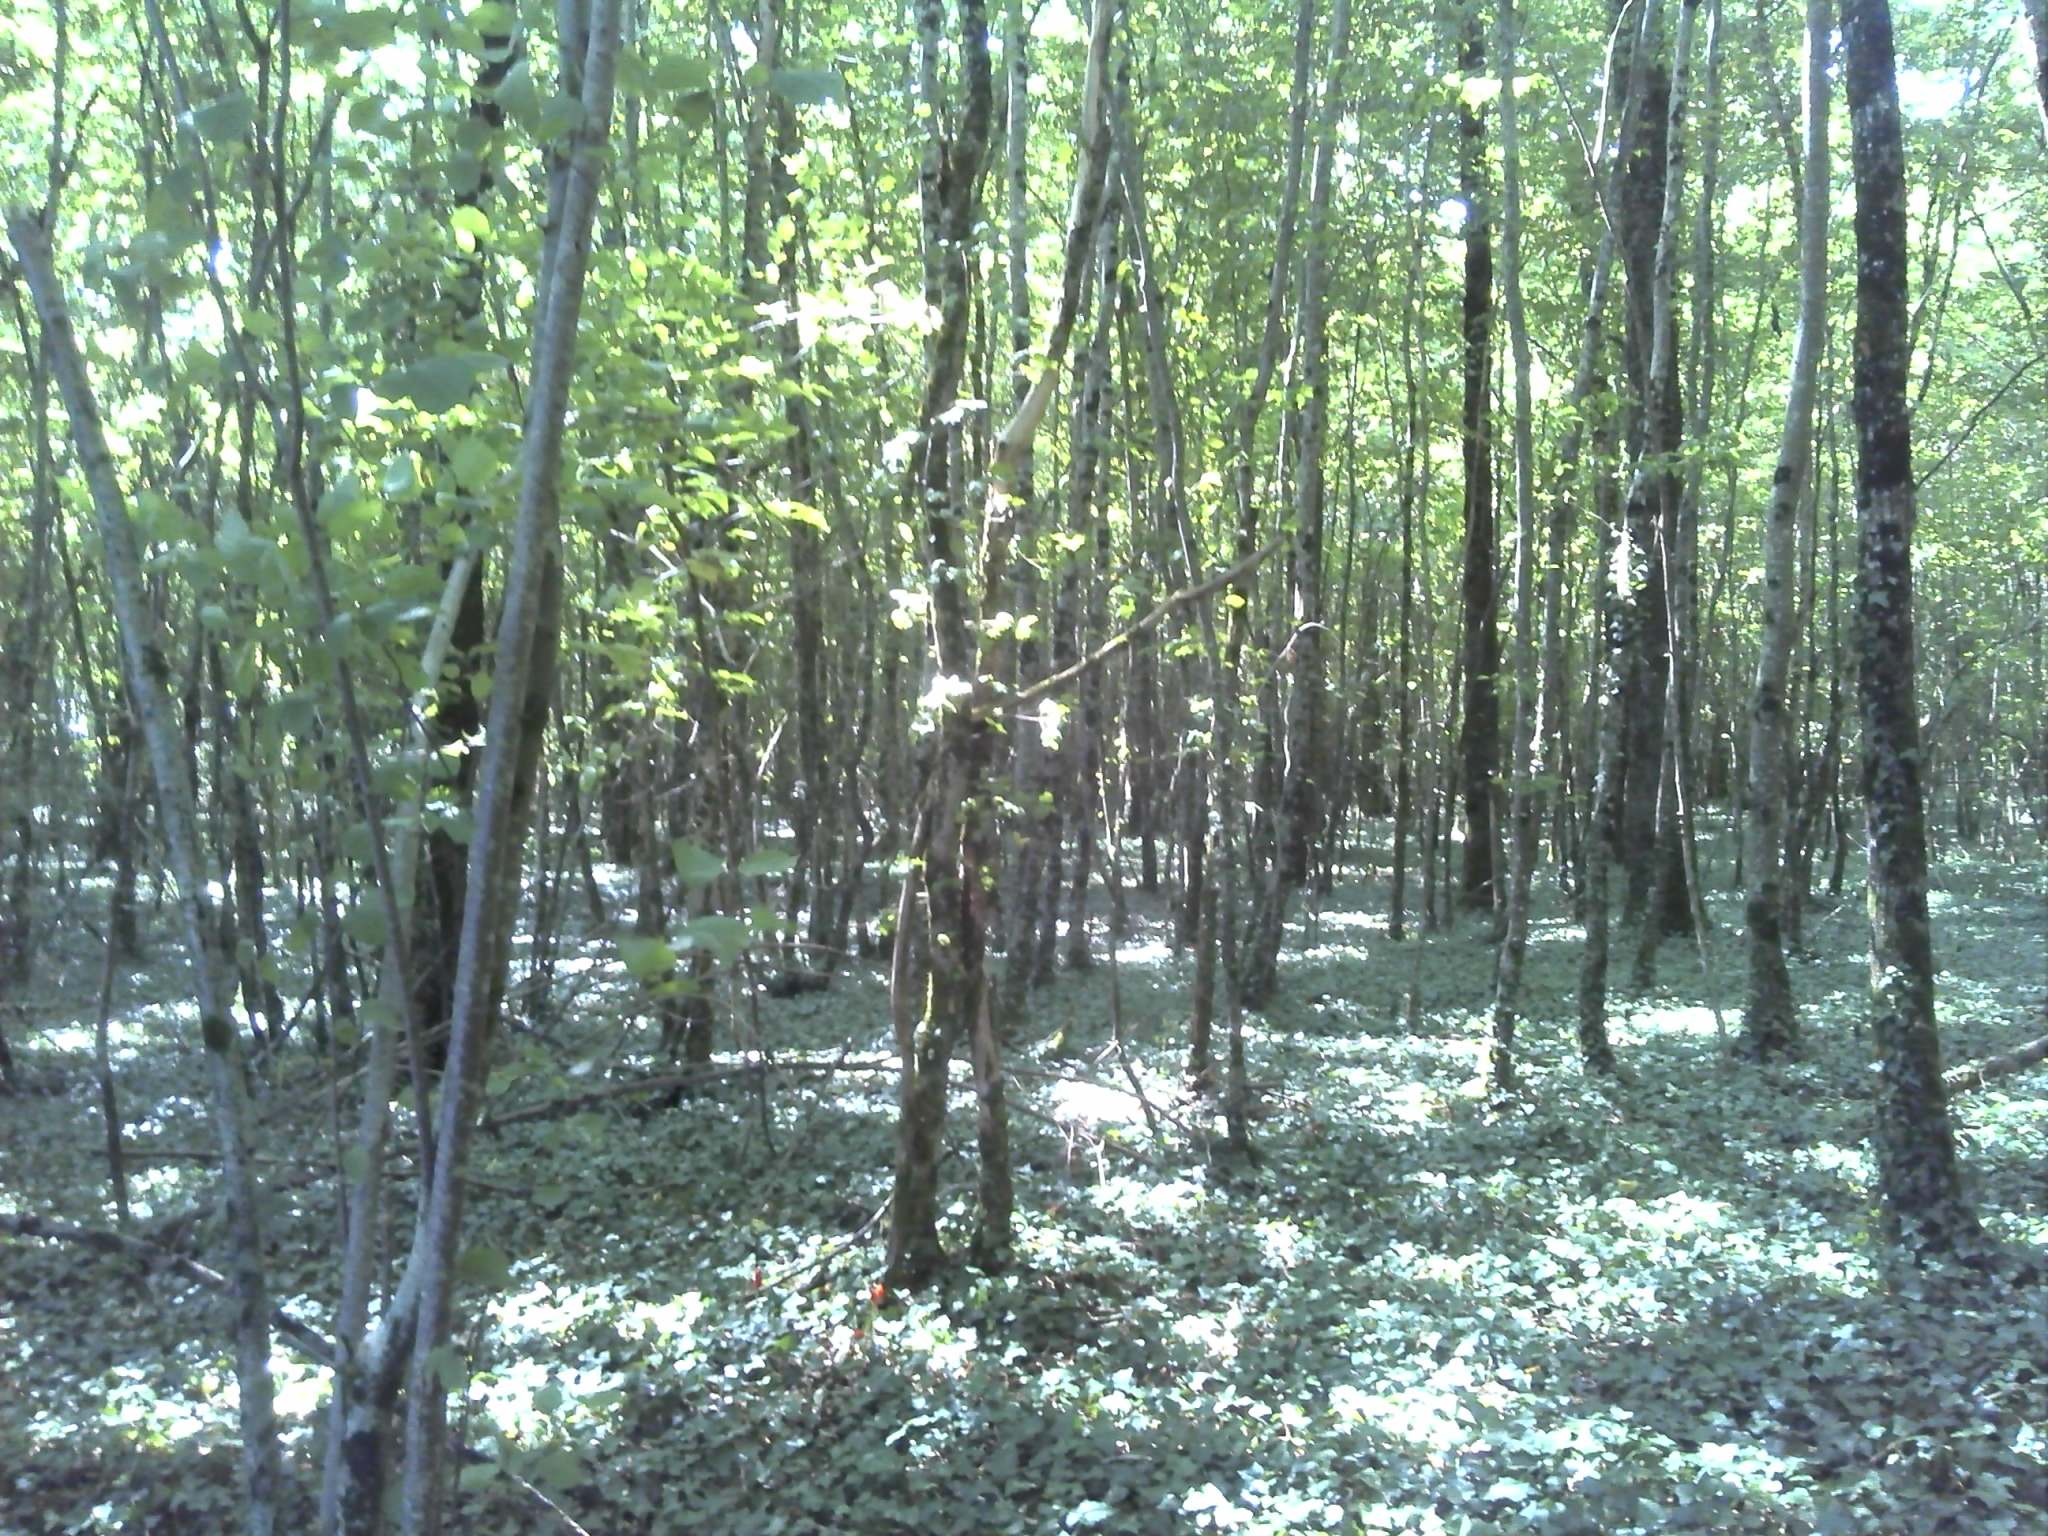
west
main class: Woodland
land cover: Broadleaved woodland
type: mesophytic deciduous forest
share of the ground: > 75 %
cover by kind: broadleaved forest trees 70 %, herbaceous plants 30 %
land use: Forestry
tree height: > 5 m
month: August
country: FR
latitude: 46.8675
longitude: 1.5533
